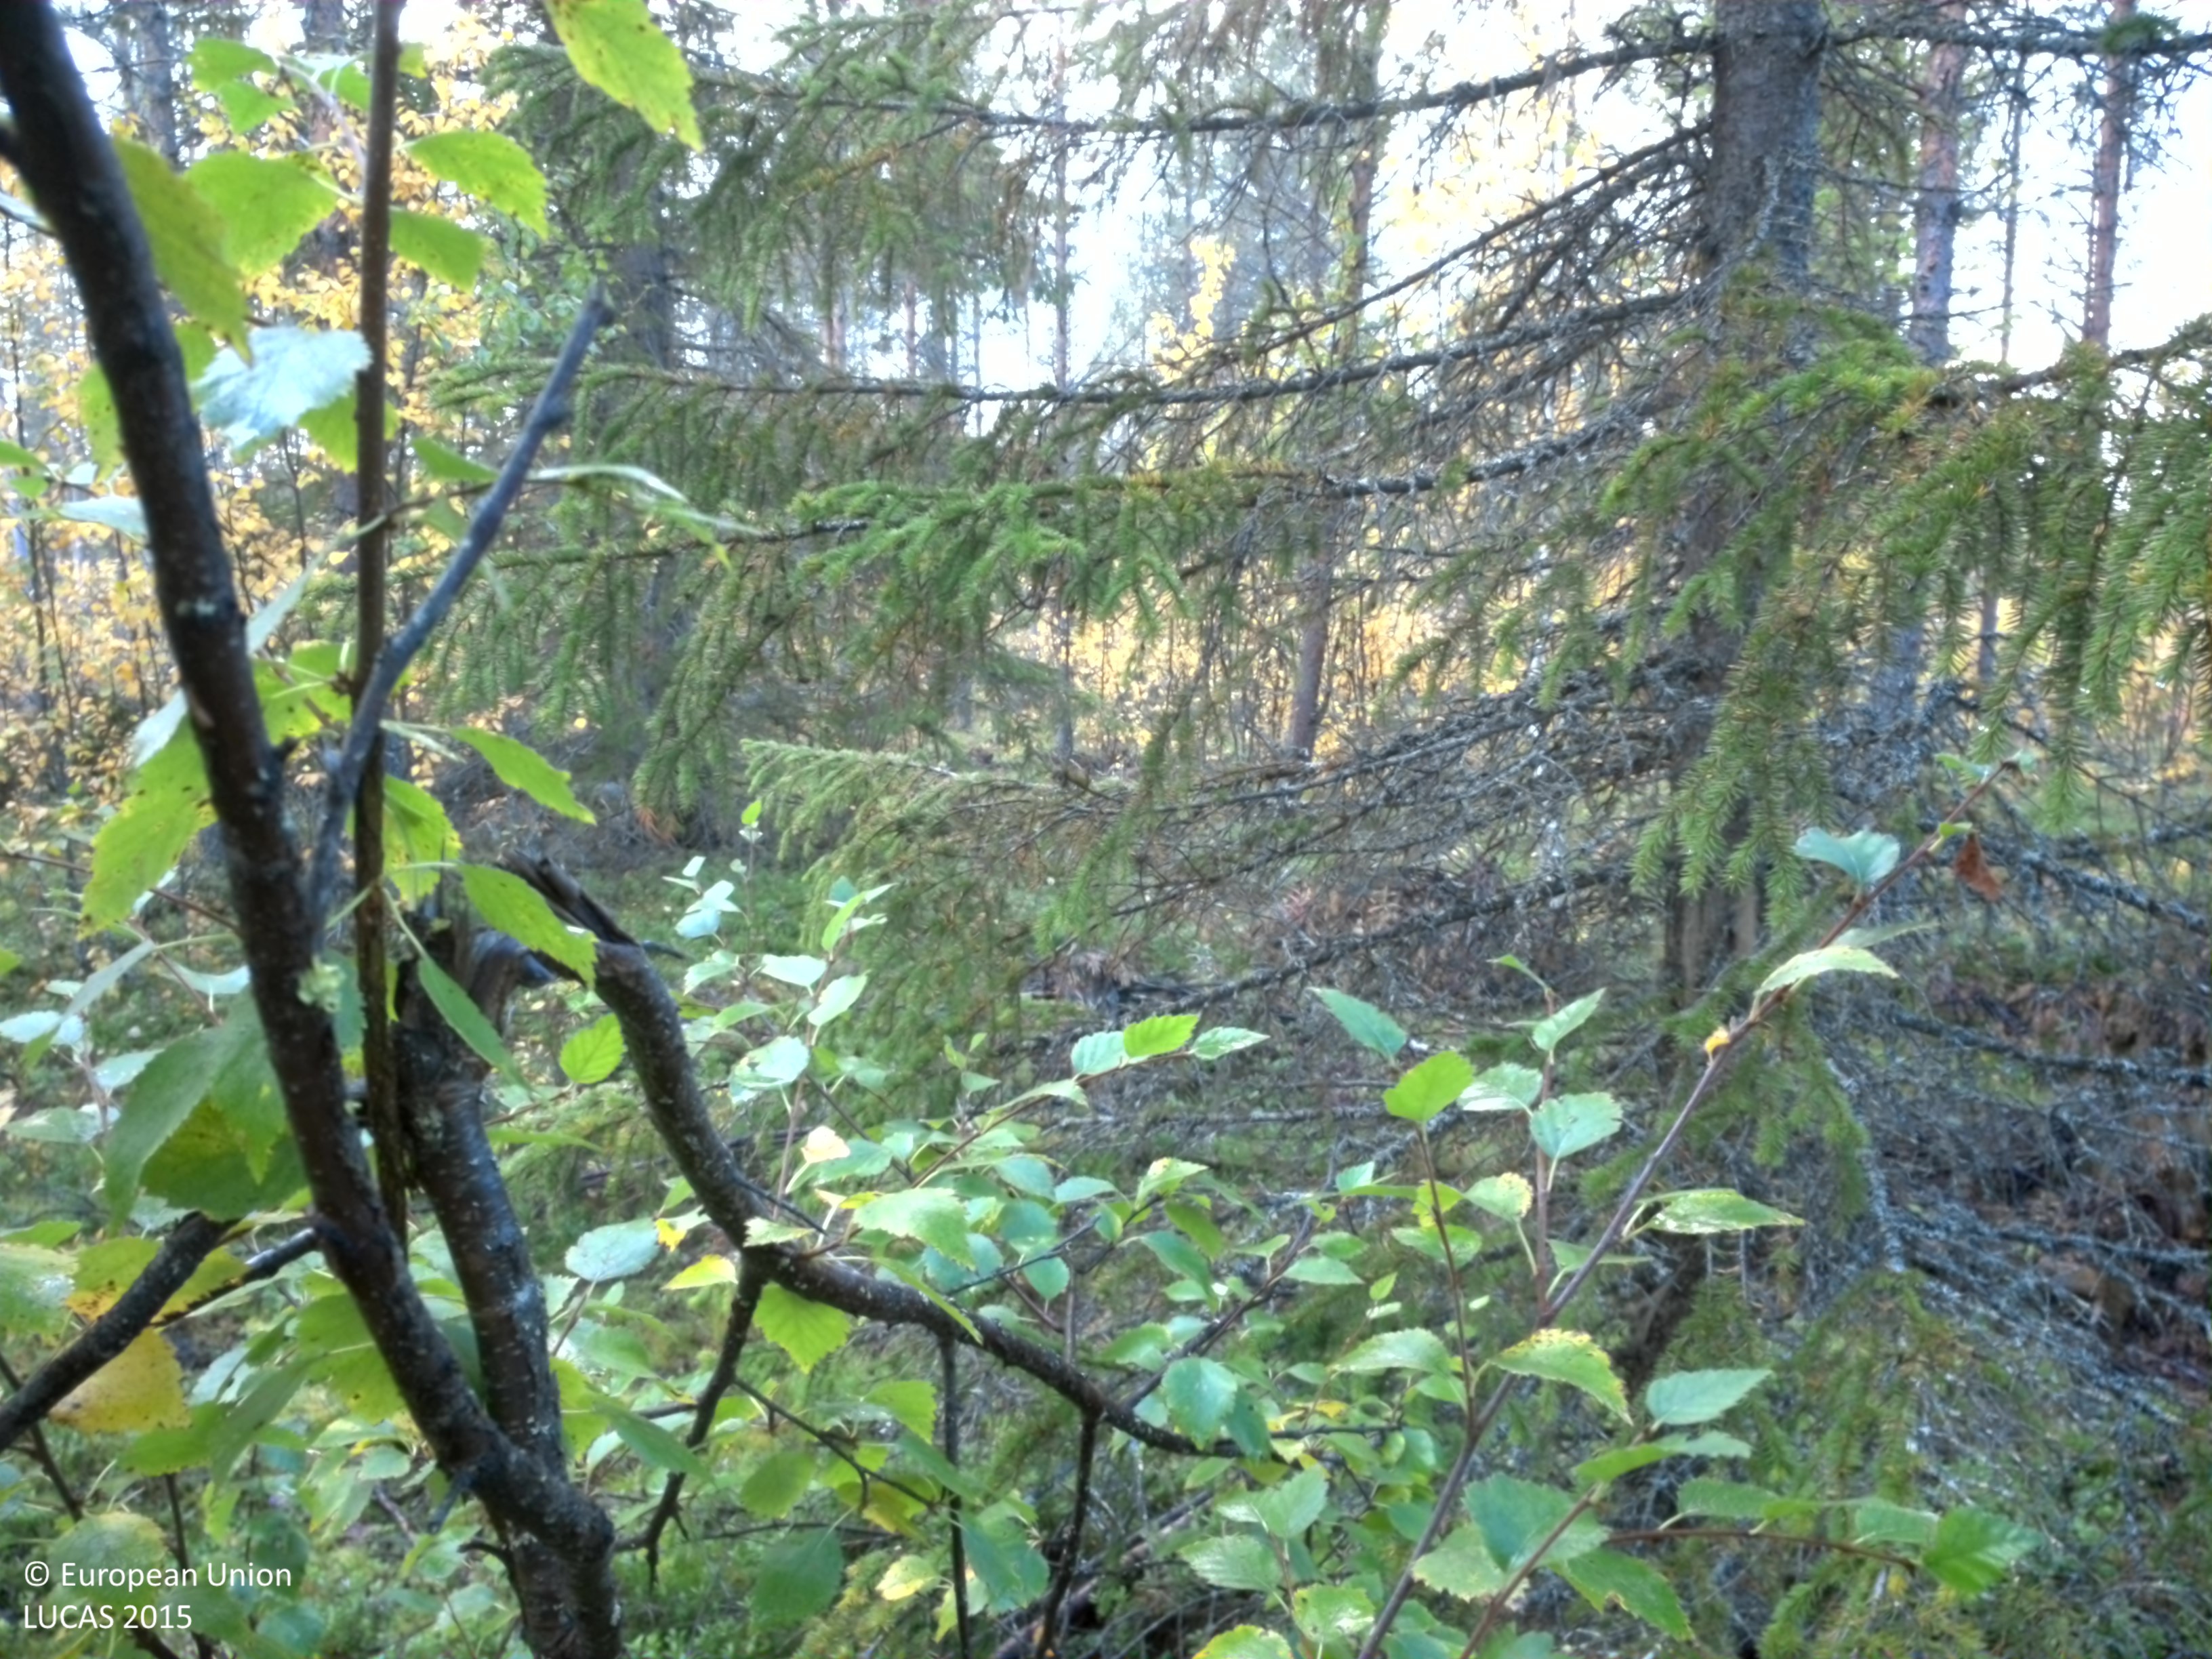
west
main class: Woodland
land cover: Pine dominated mixed woodland
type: boreal forest
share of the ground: 25 - 50 %
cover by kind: shrubs 35 %, coniferous forest trees 25 %, lichens and mosses 15 %, broadleaved forest trees 10 %, herbaceous plants 10 %
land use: Forestry
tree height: > 5 m
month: September
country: SE
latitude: 65.2232
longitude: 16.5711
